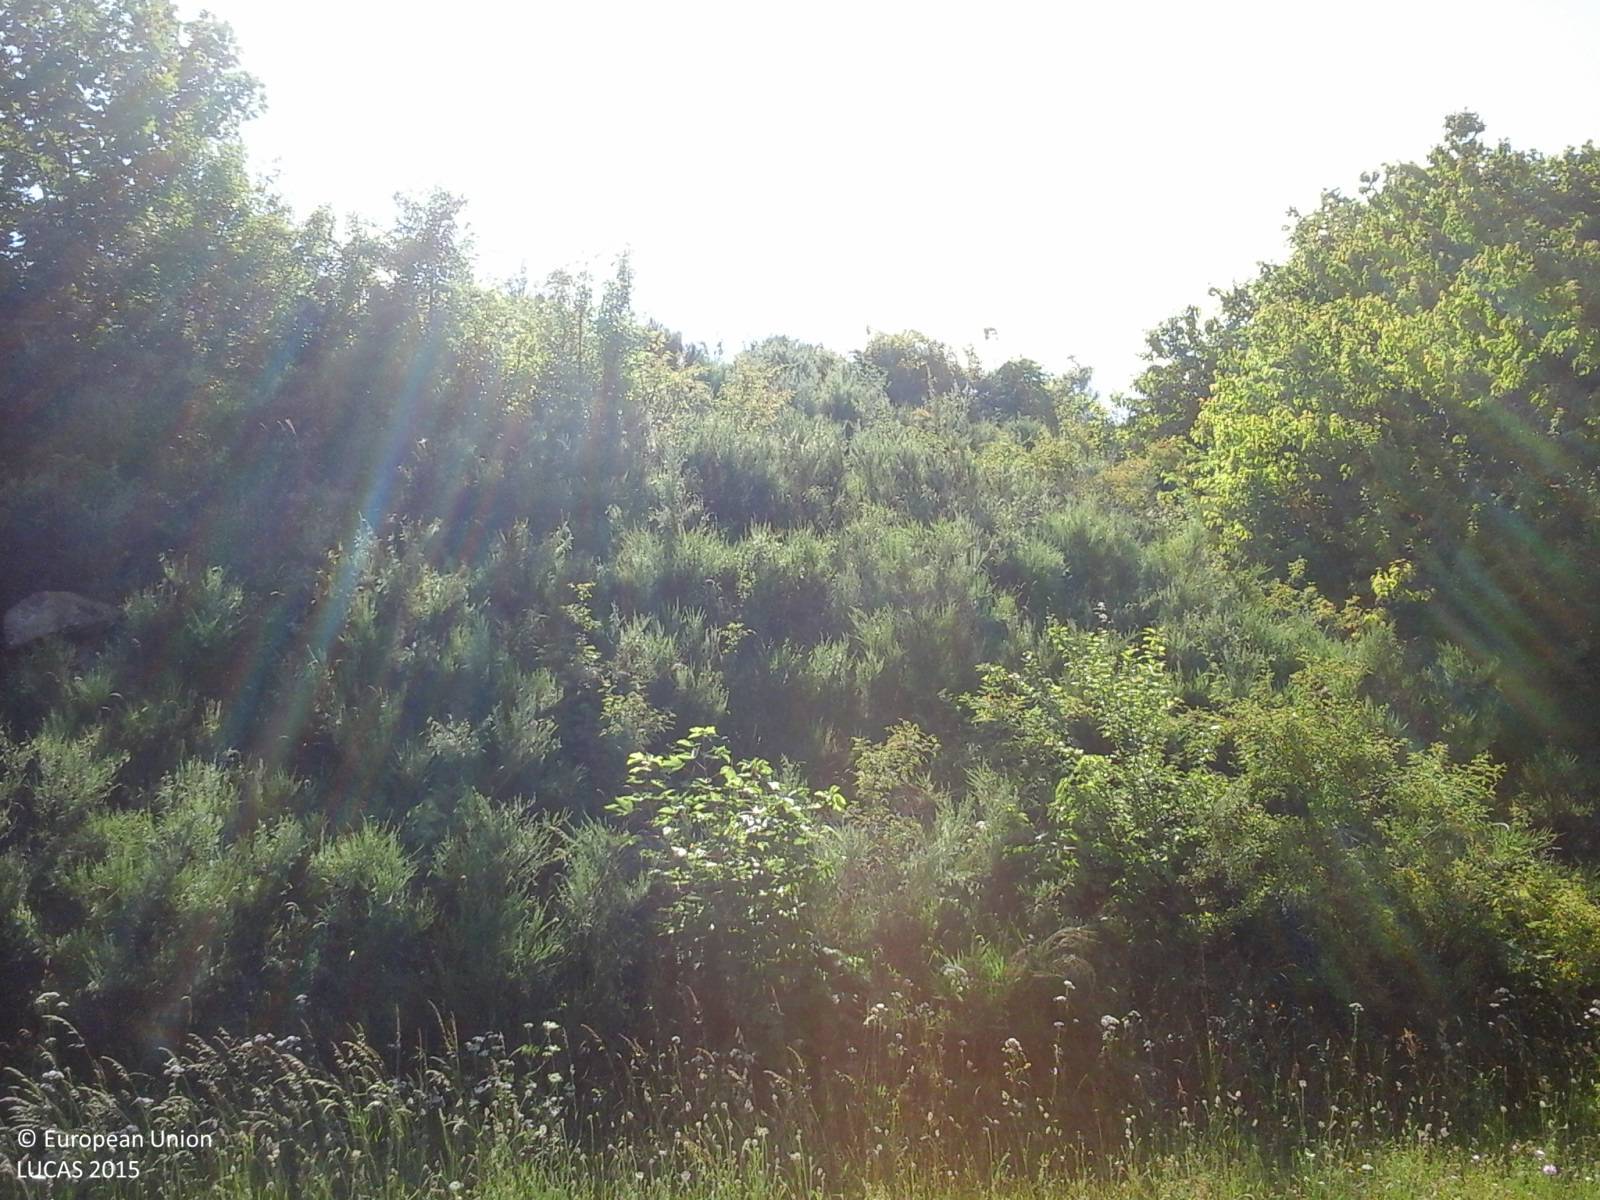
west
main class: Shrubland
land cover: Shrubland with sparse tree cover
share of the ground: > 75 %
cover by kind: shrubs 90 %, broadleaved forest trees 5 %, herbaceous plants 5 %
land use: Semi-natural and natural areas not in use
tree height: < 5 m
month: September
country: IT
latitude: 42.5260
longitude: 13.3616
